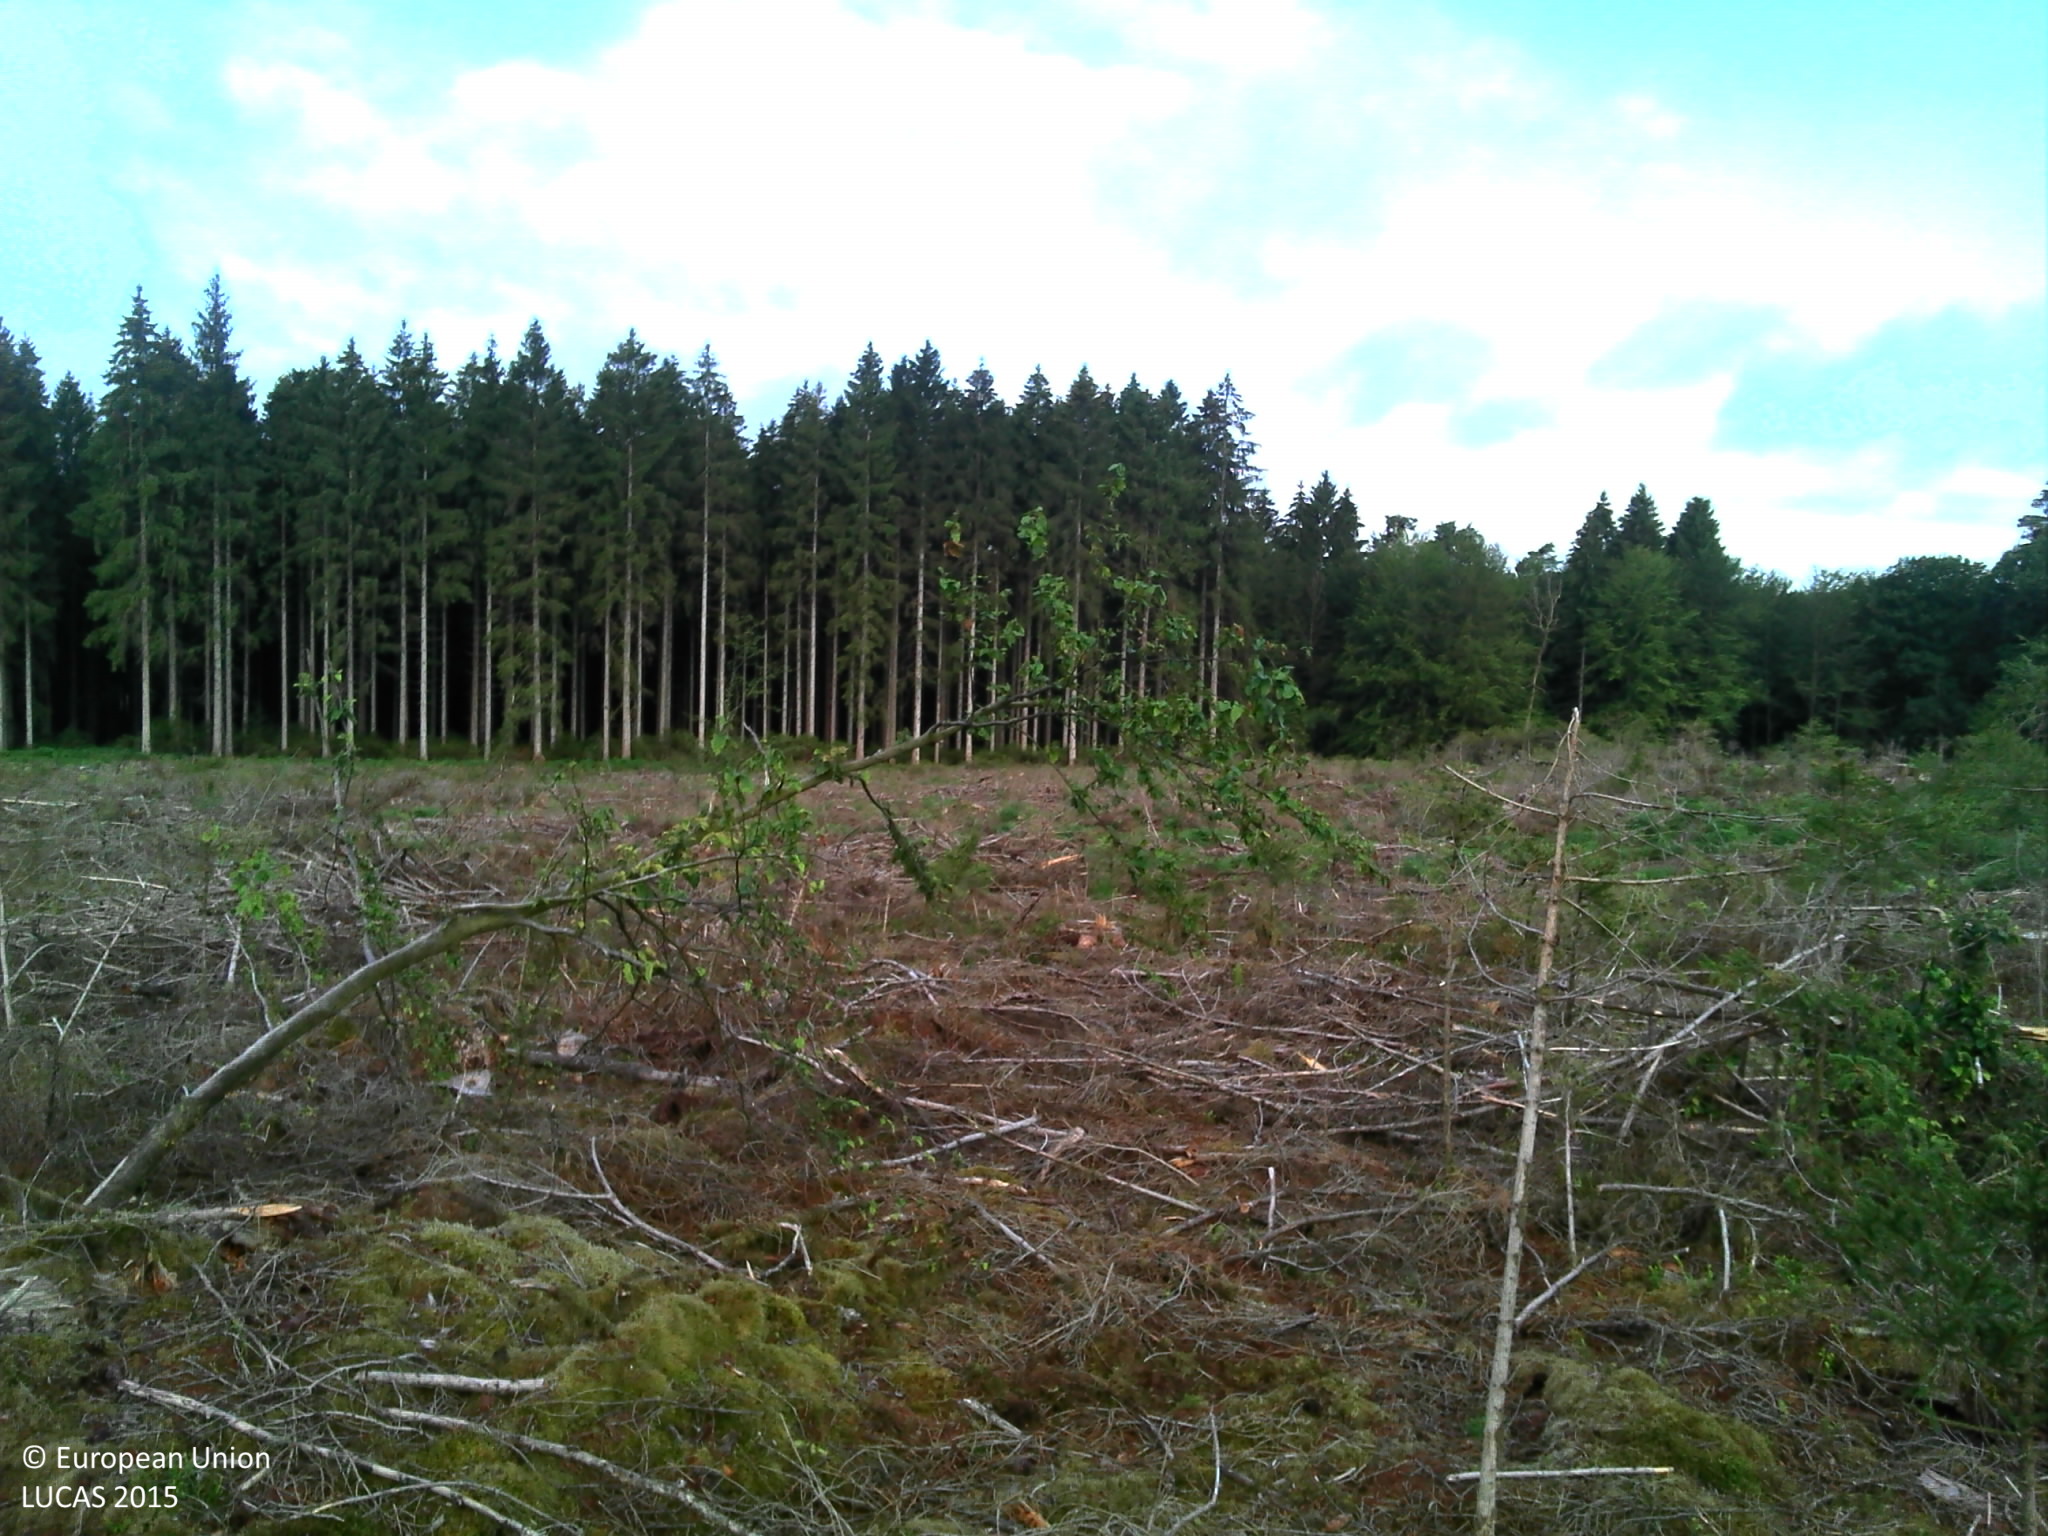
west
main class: Grassland
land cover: Spontaneously vegetated surfaces
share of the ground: 50 - 75 %
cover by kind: herbaceous plants 65 %, unconsolidated bare surface 30 %, shrubs 5 %
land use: Forestry
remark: Clear cut
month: July
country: BE
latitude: 49.7639
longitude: 5.3195
